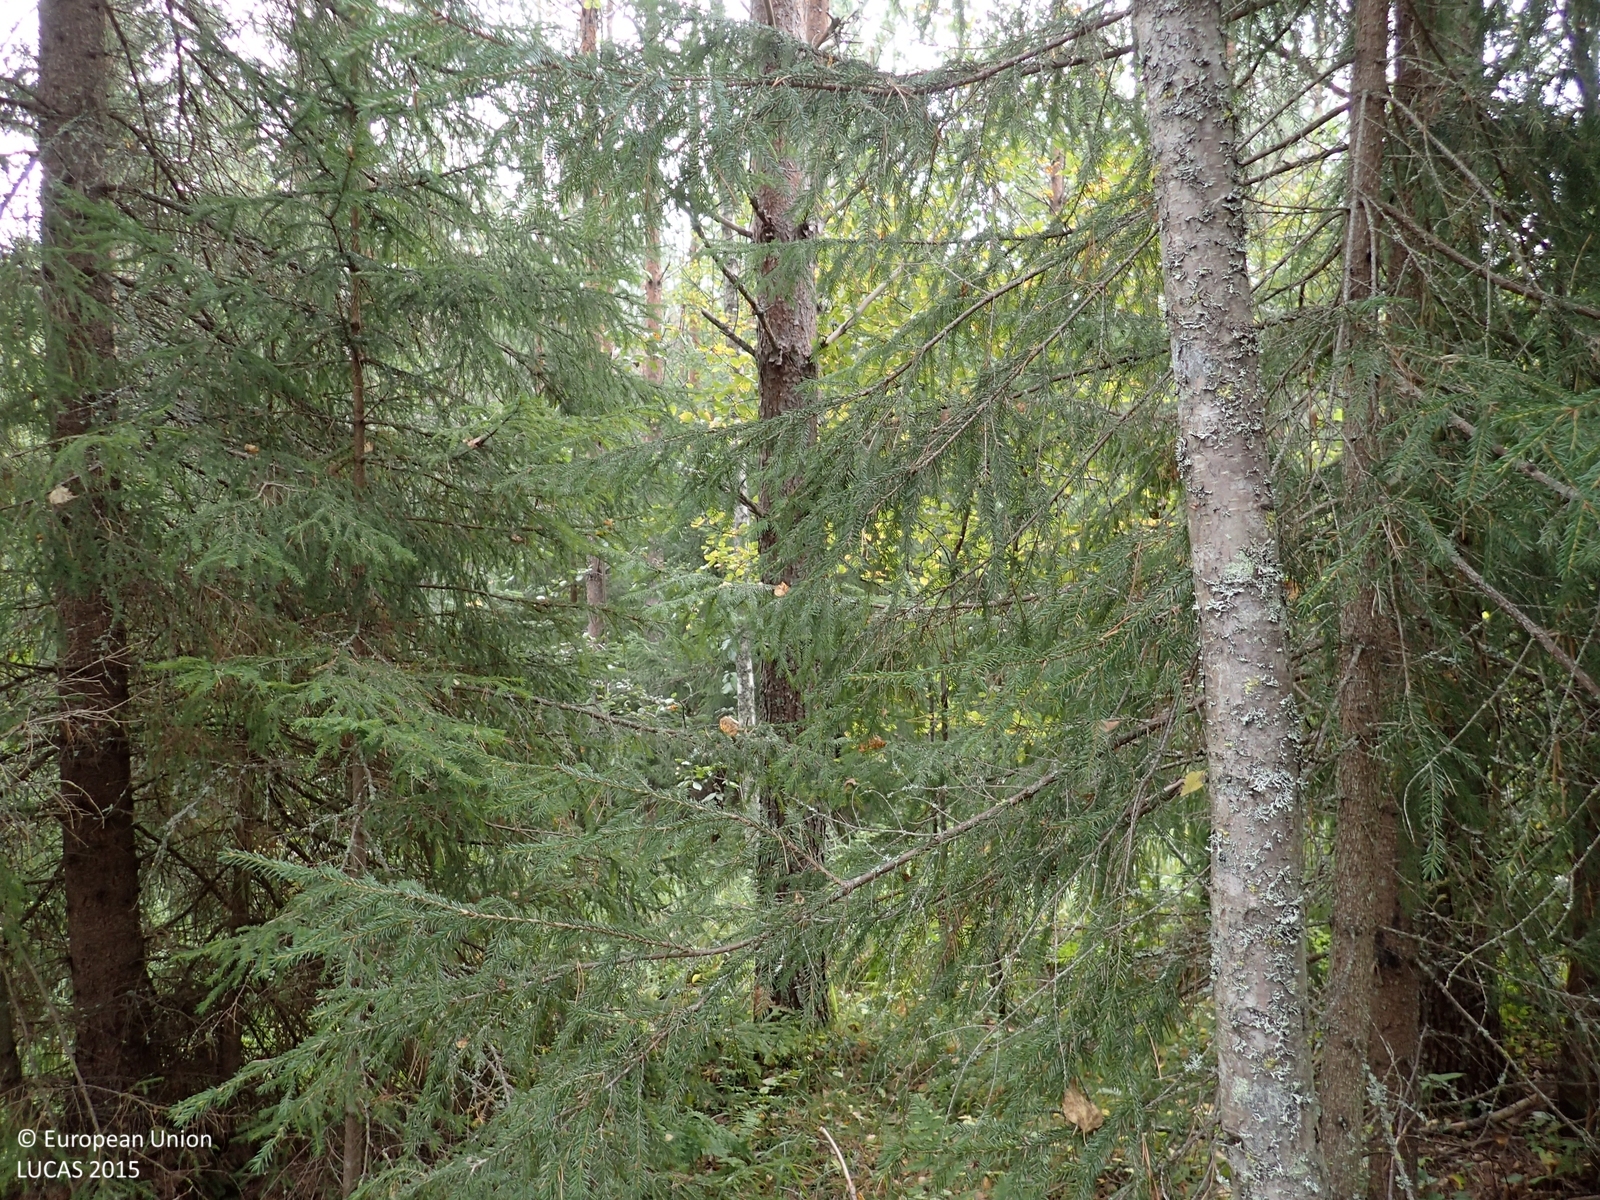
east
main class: Woodland
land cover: Pine dominated mixed woodland
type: boreal forest
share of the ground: > 75 %
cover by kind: coniferous forest trees 55 %, broadleaved forest trees 20 %, herbaceous plants 15 %, shrubs 5 %, lichens and mosses 5 %
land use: Forestry
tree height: > 5 m
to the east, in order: Pine dominated mixed woodland; Spruce dominated mixed woodland; Ditches and canals; Spruce dominated coniferous woodland; Pine dominated mixed woodland; Pine dominated coniferous woodland
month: September
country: FI
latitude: 62.9414
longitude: 25.9002
